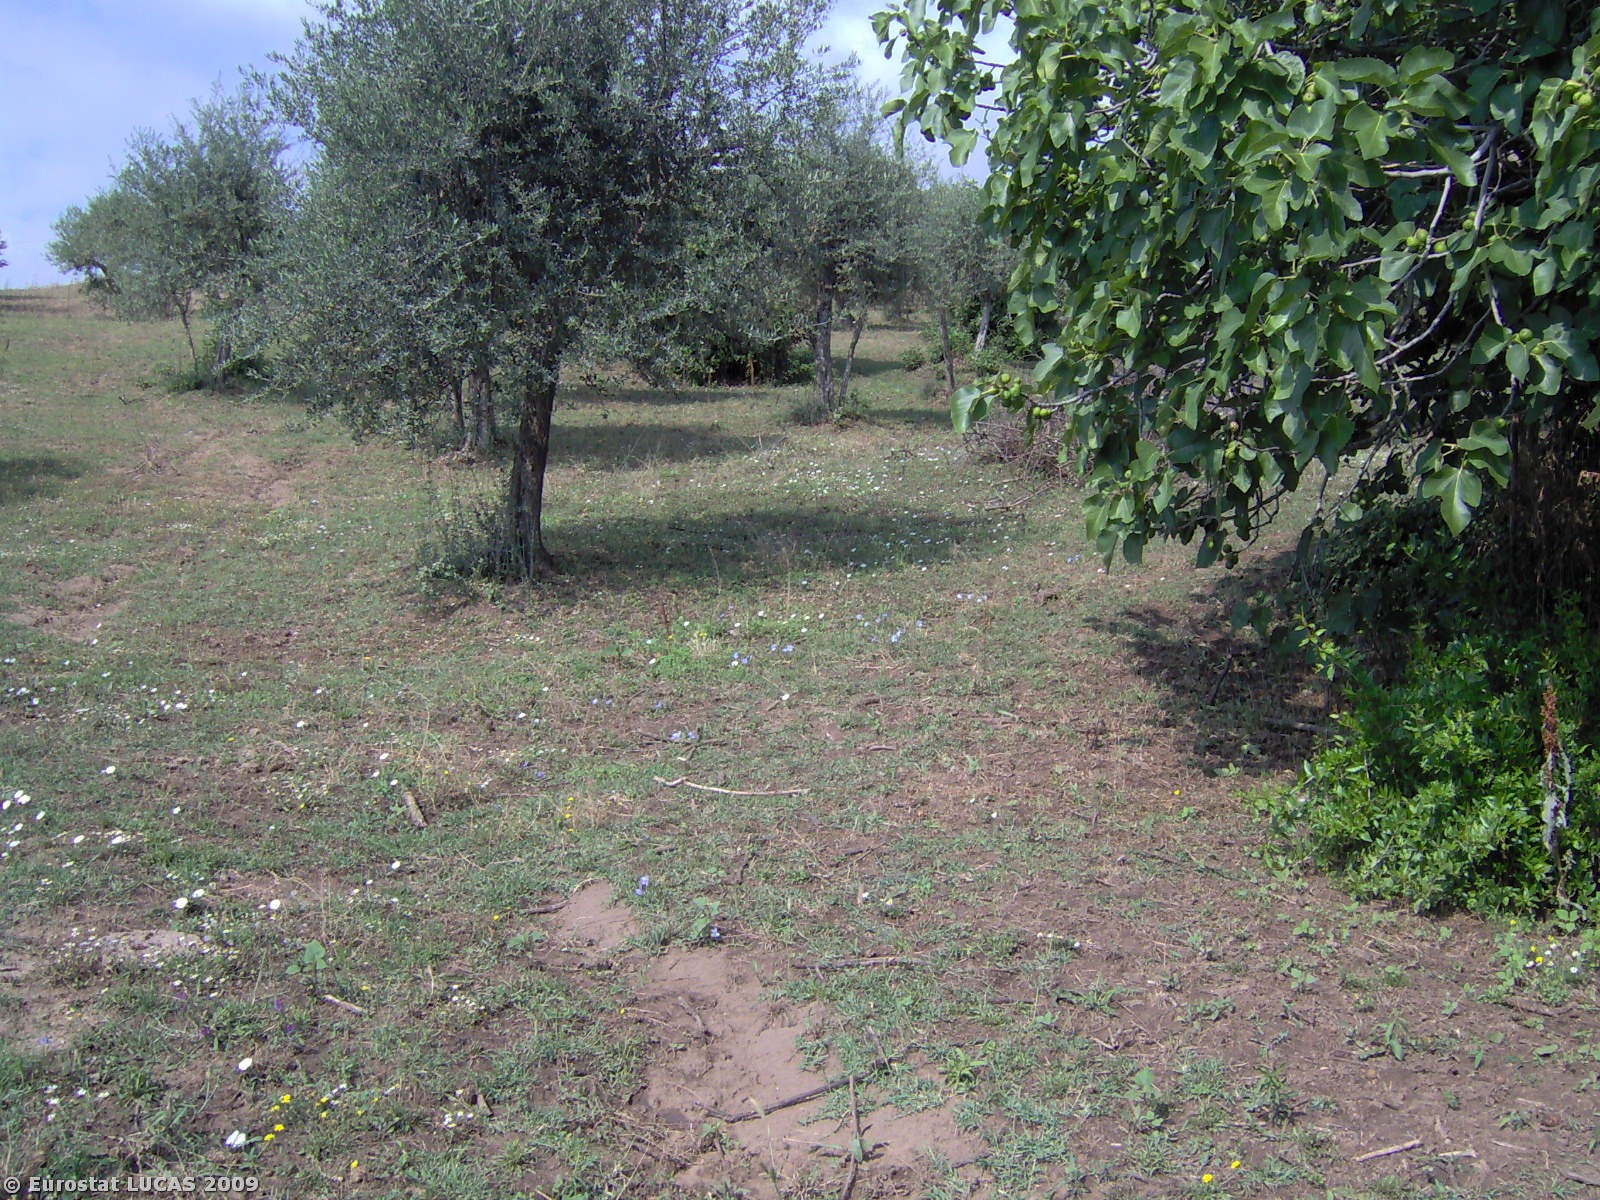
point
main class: Cropland
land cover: Olive groves
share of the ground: 50 - 75 %
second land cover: Bare land
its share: > 75 %
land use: Agriculture (excluding fallow land and kitchen gardens)
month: July
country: IT
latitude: 40.9956
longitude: 15.6026
